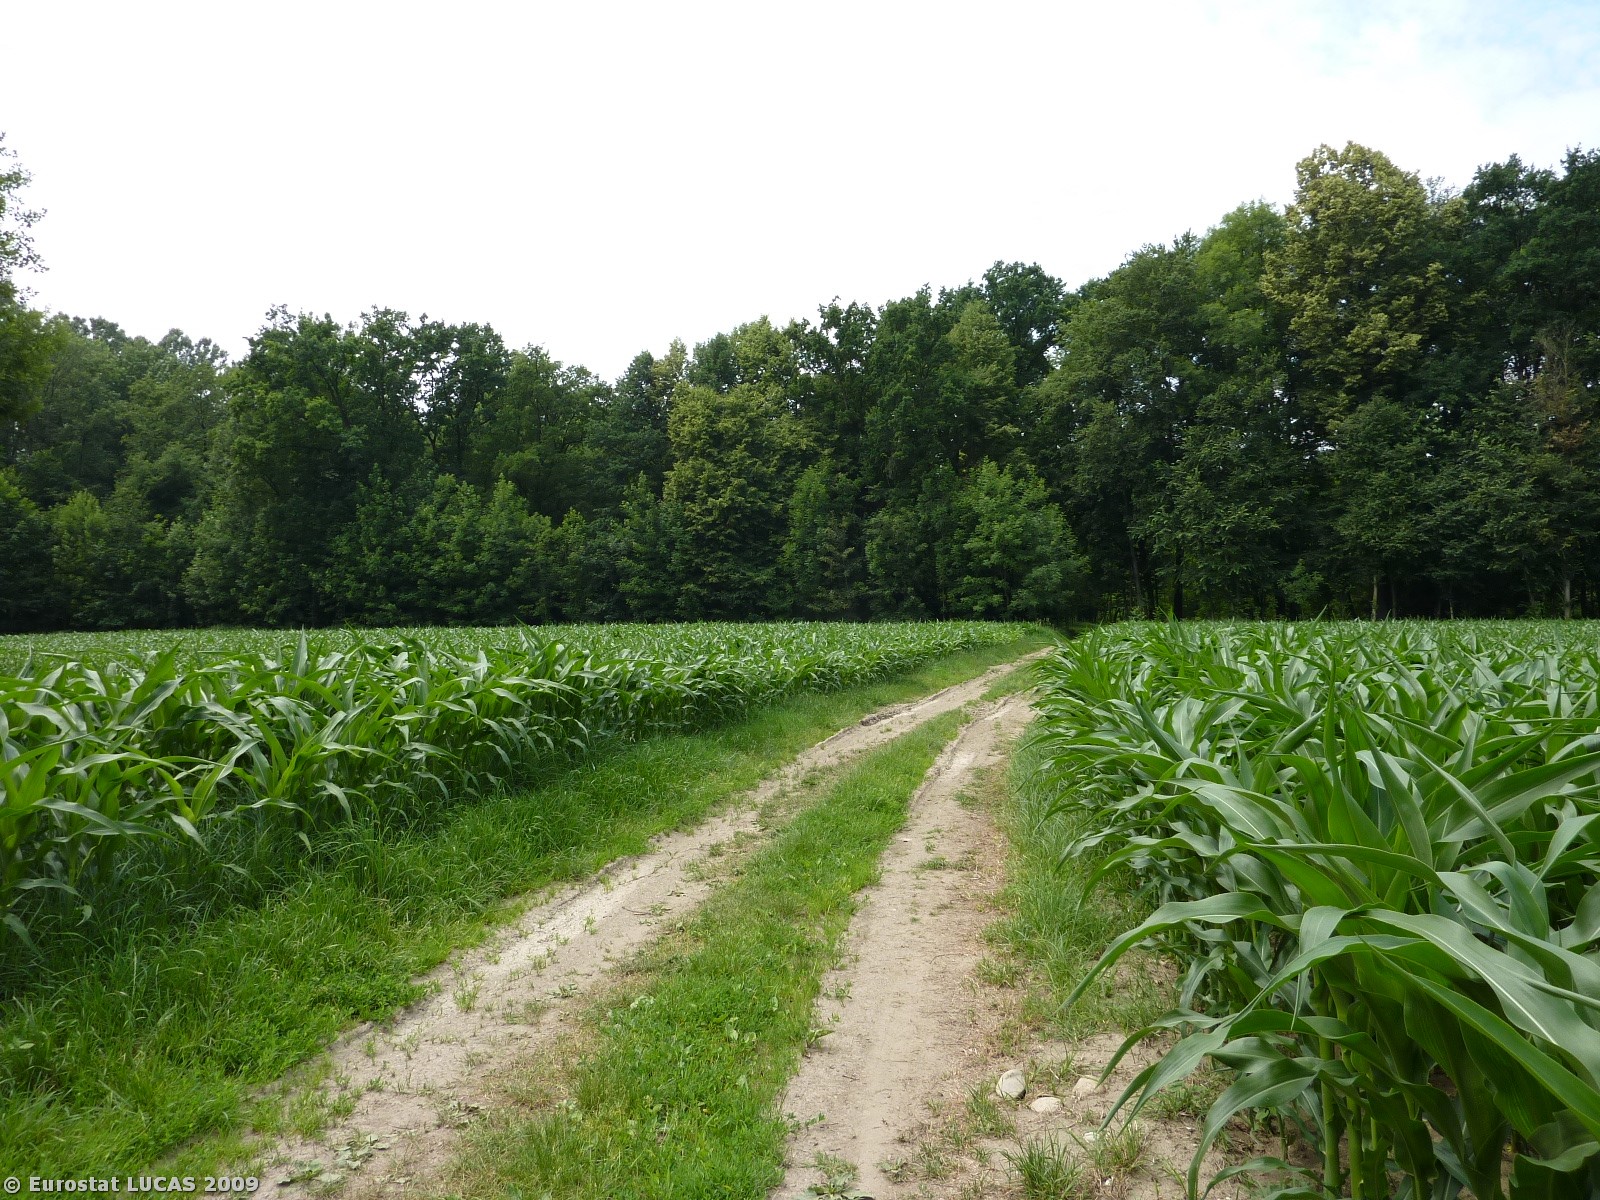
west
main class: Cropland
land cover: Maize
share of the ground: > 75 %
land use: Agriculture (excluding fallow land and kitchen gardens)
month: June
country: AT
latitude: 46.7053
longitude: 15.6891
